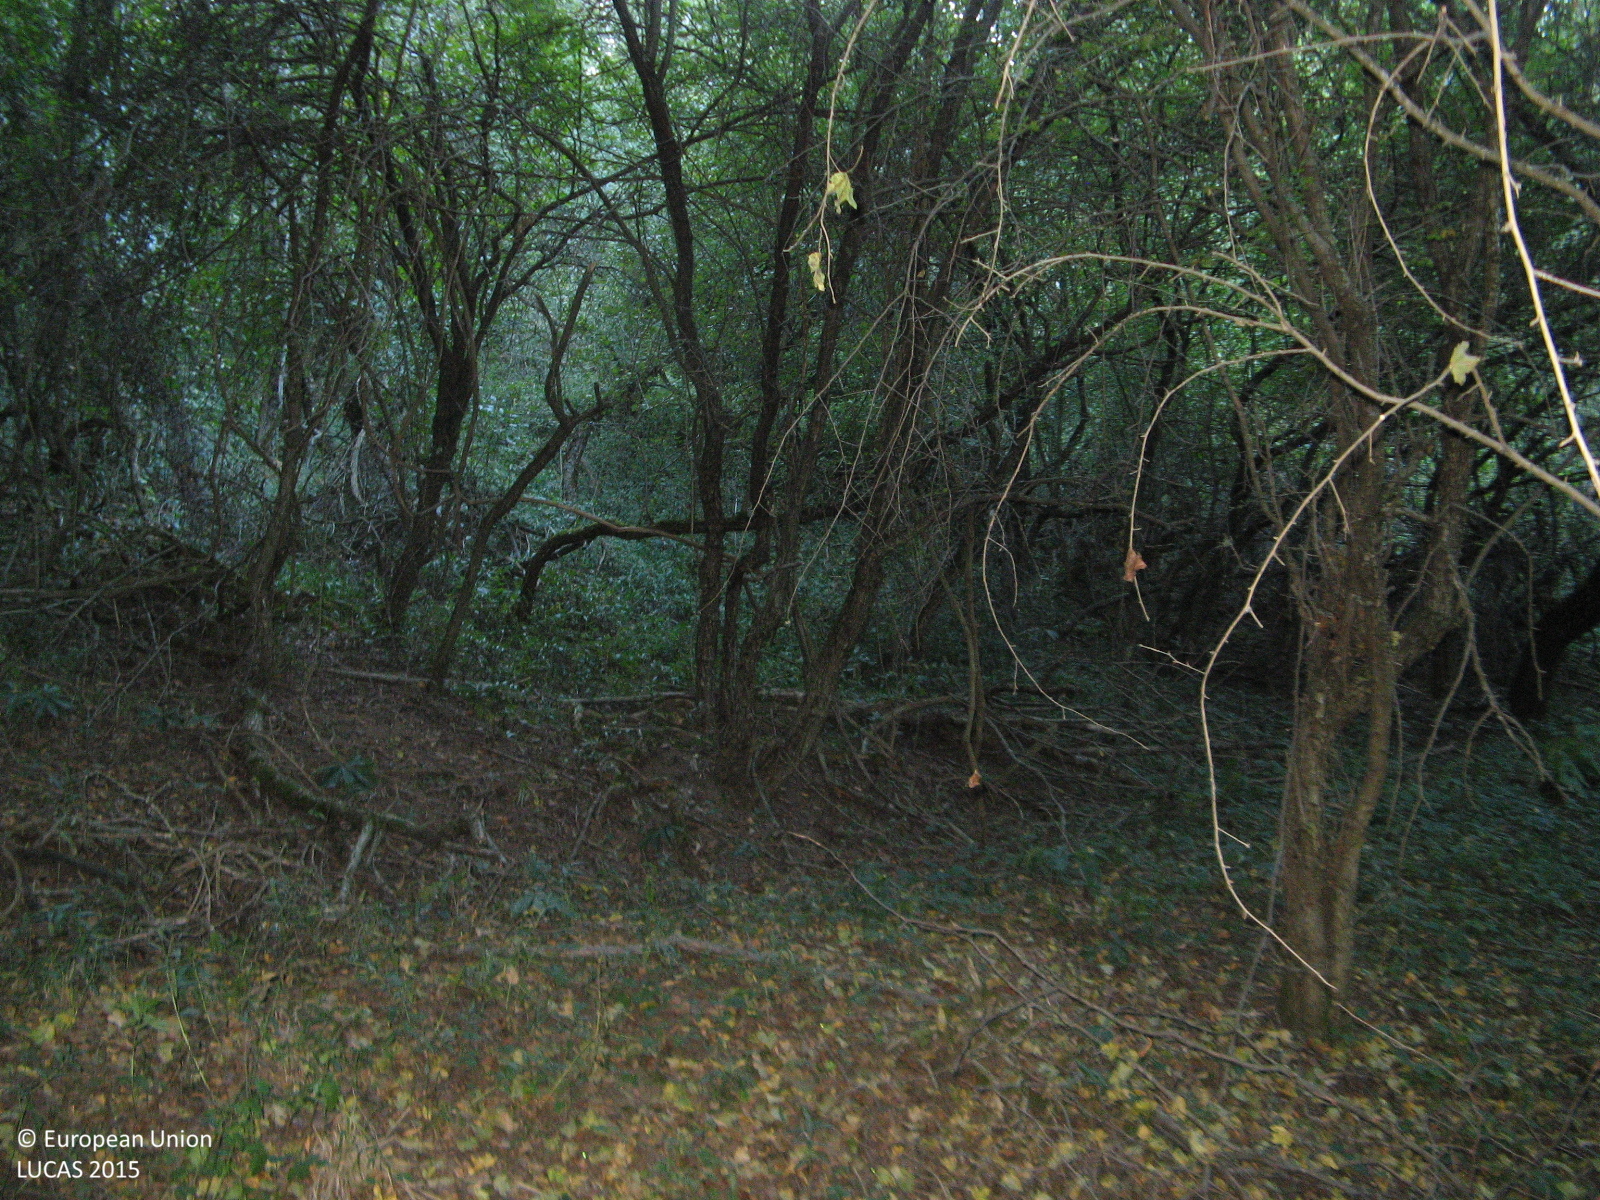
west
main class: Woodland
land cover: Broadleaved woodland
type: thermophilous deciduous forest
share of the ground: > 75 %
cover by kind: broadleaved forest trees 95 %, shrubs 5 %
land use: Forestry
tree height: > 5 m
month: September
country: BG
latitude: 43.5467
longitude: 26.0737
